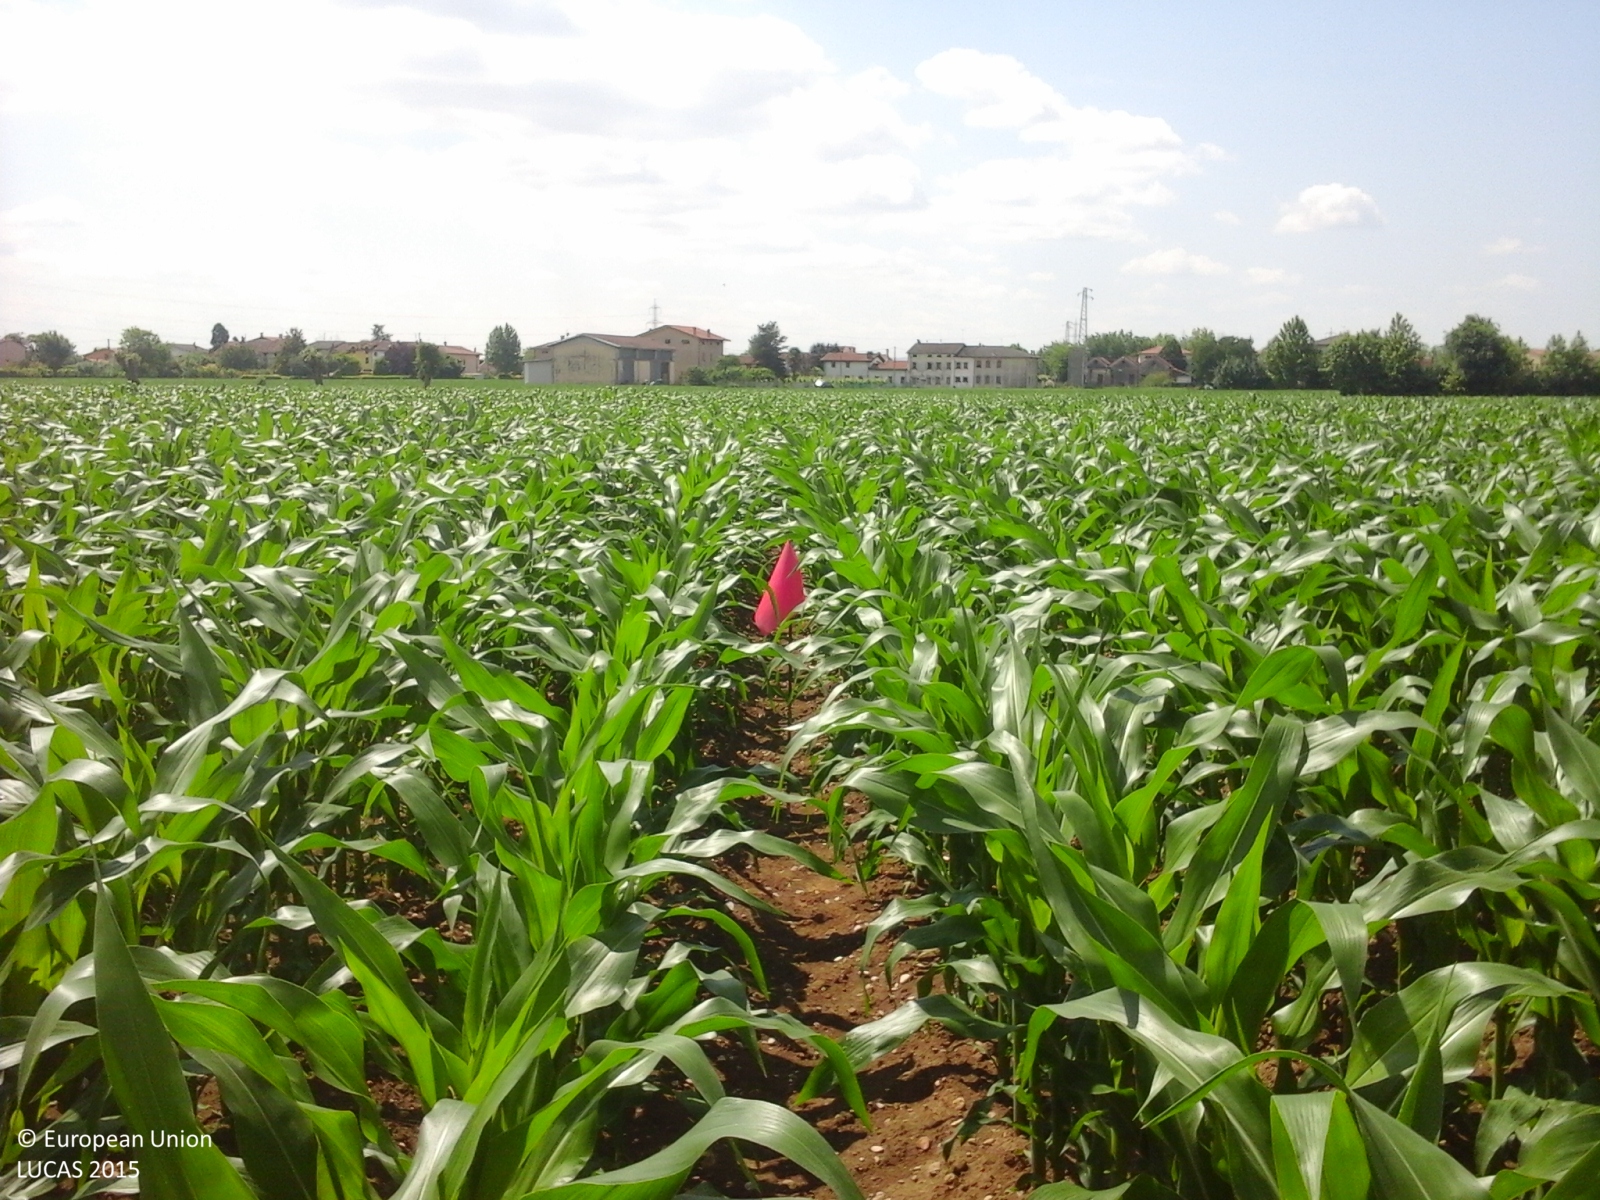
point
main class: Cropland
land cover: Maize
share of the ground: > 75 %
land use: Agriculture (excluding fallow land and kitchen gardens)
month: May
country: IT
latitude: 45.6545
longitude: 11.6016
